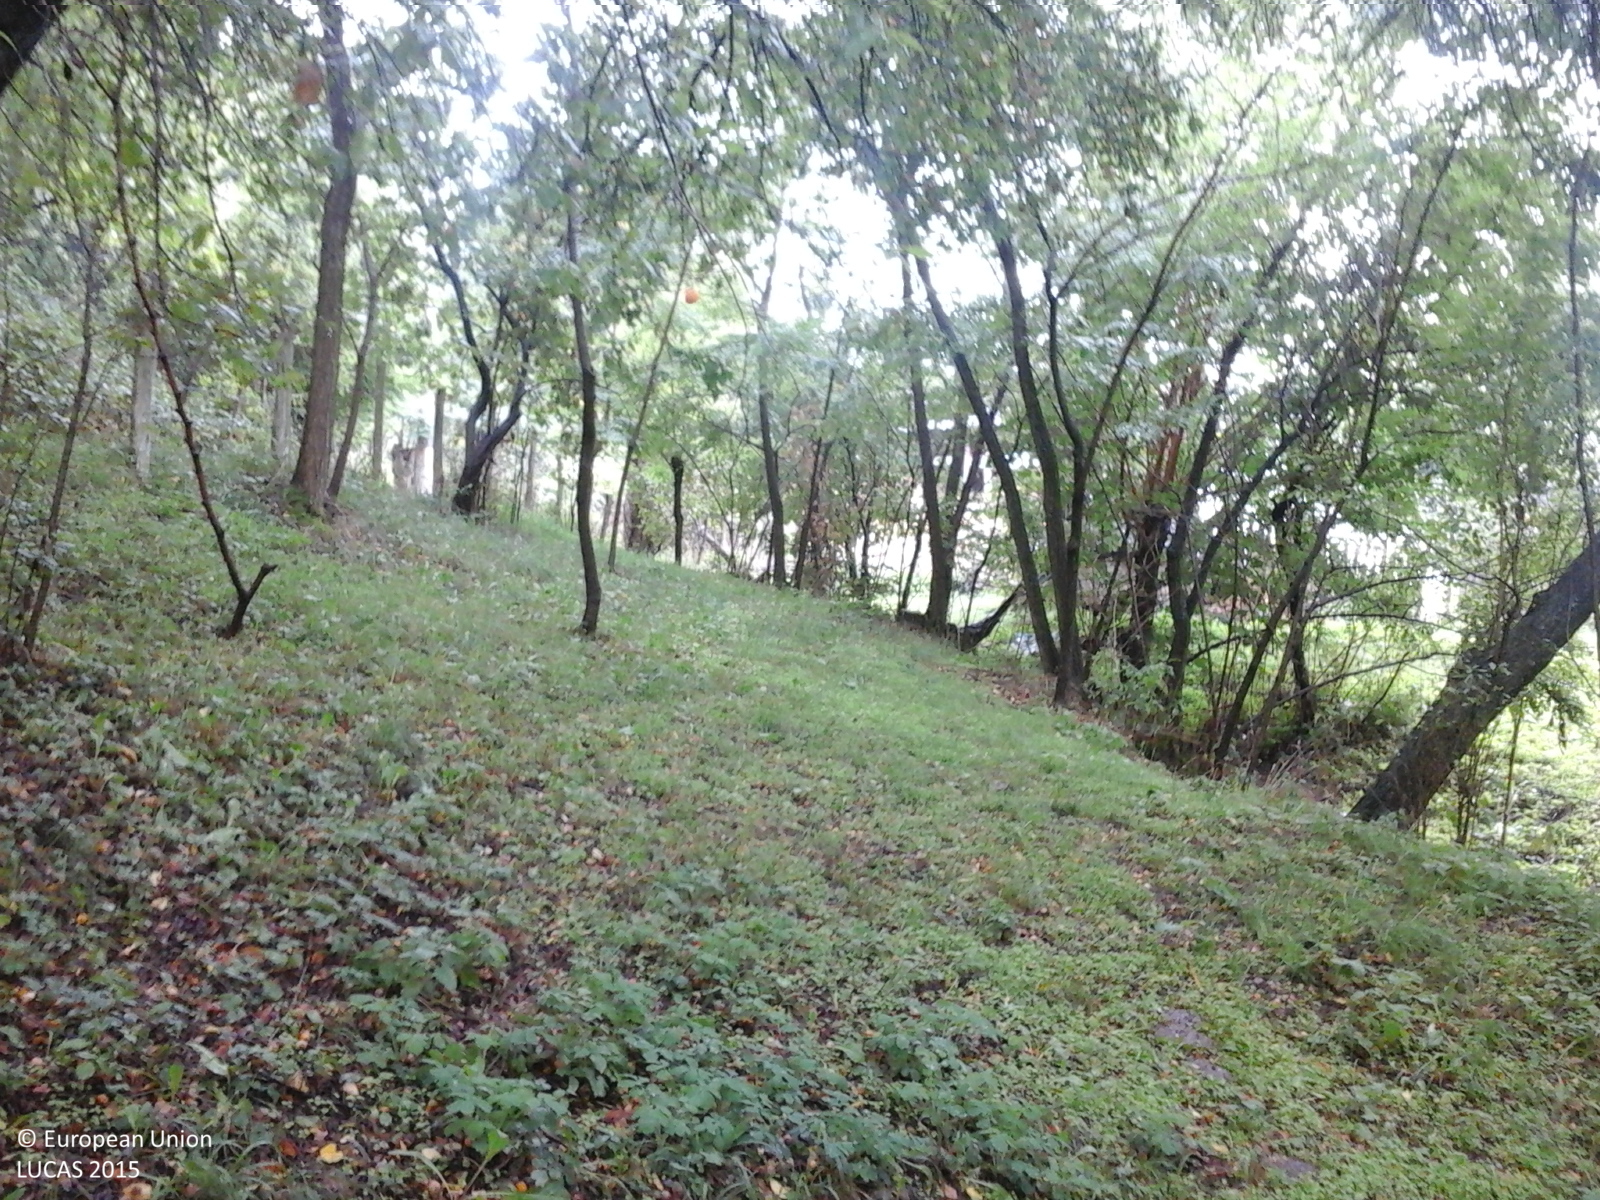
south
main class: Woodland
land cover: Broadleaved woodland
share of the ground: > 75 %
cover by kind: broadleaved forest trees 100 %
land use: Forestry
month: September
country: RO
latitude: 45.1571
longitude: 24.4890
